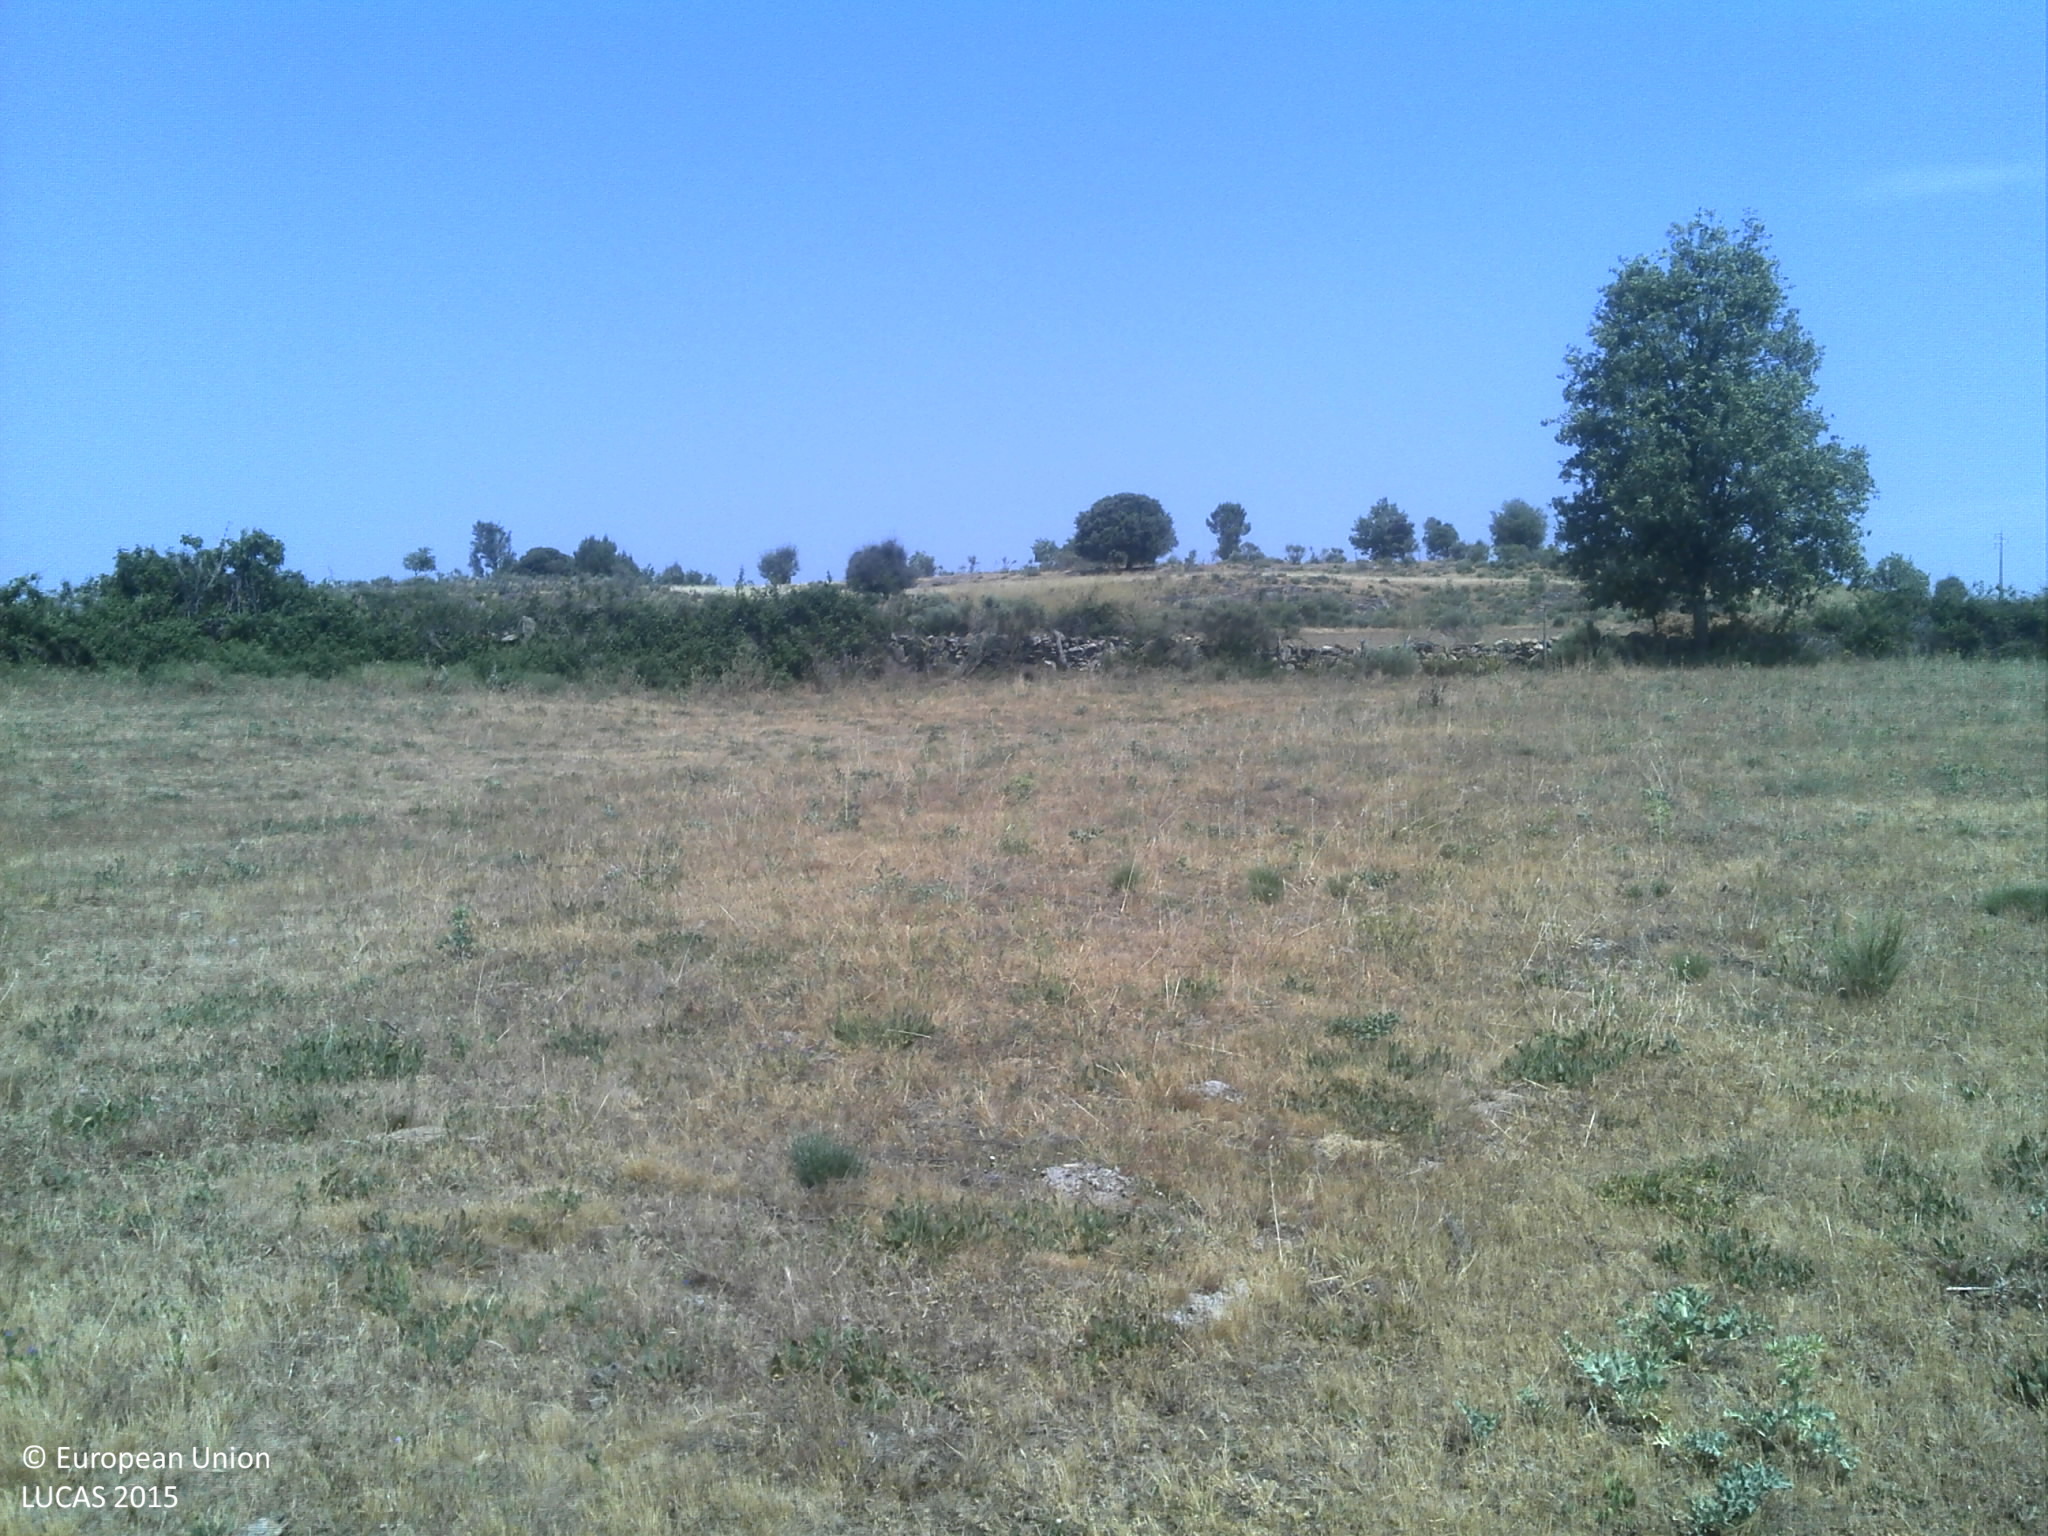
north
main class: Grassland
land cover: Grassland without tree/shrub cover
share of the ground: 50 - 75 %
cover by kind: herbaceous plants 70 %, unconsolidated bare surface 20 %
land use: Agriculture (excluding fallow land and kitchen gardens)
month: June
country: PT
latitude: 40.3998
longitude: -6.8601
